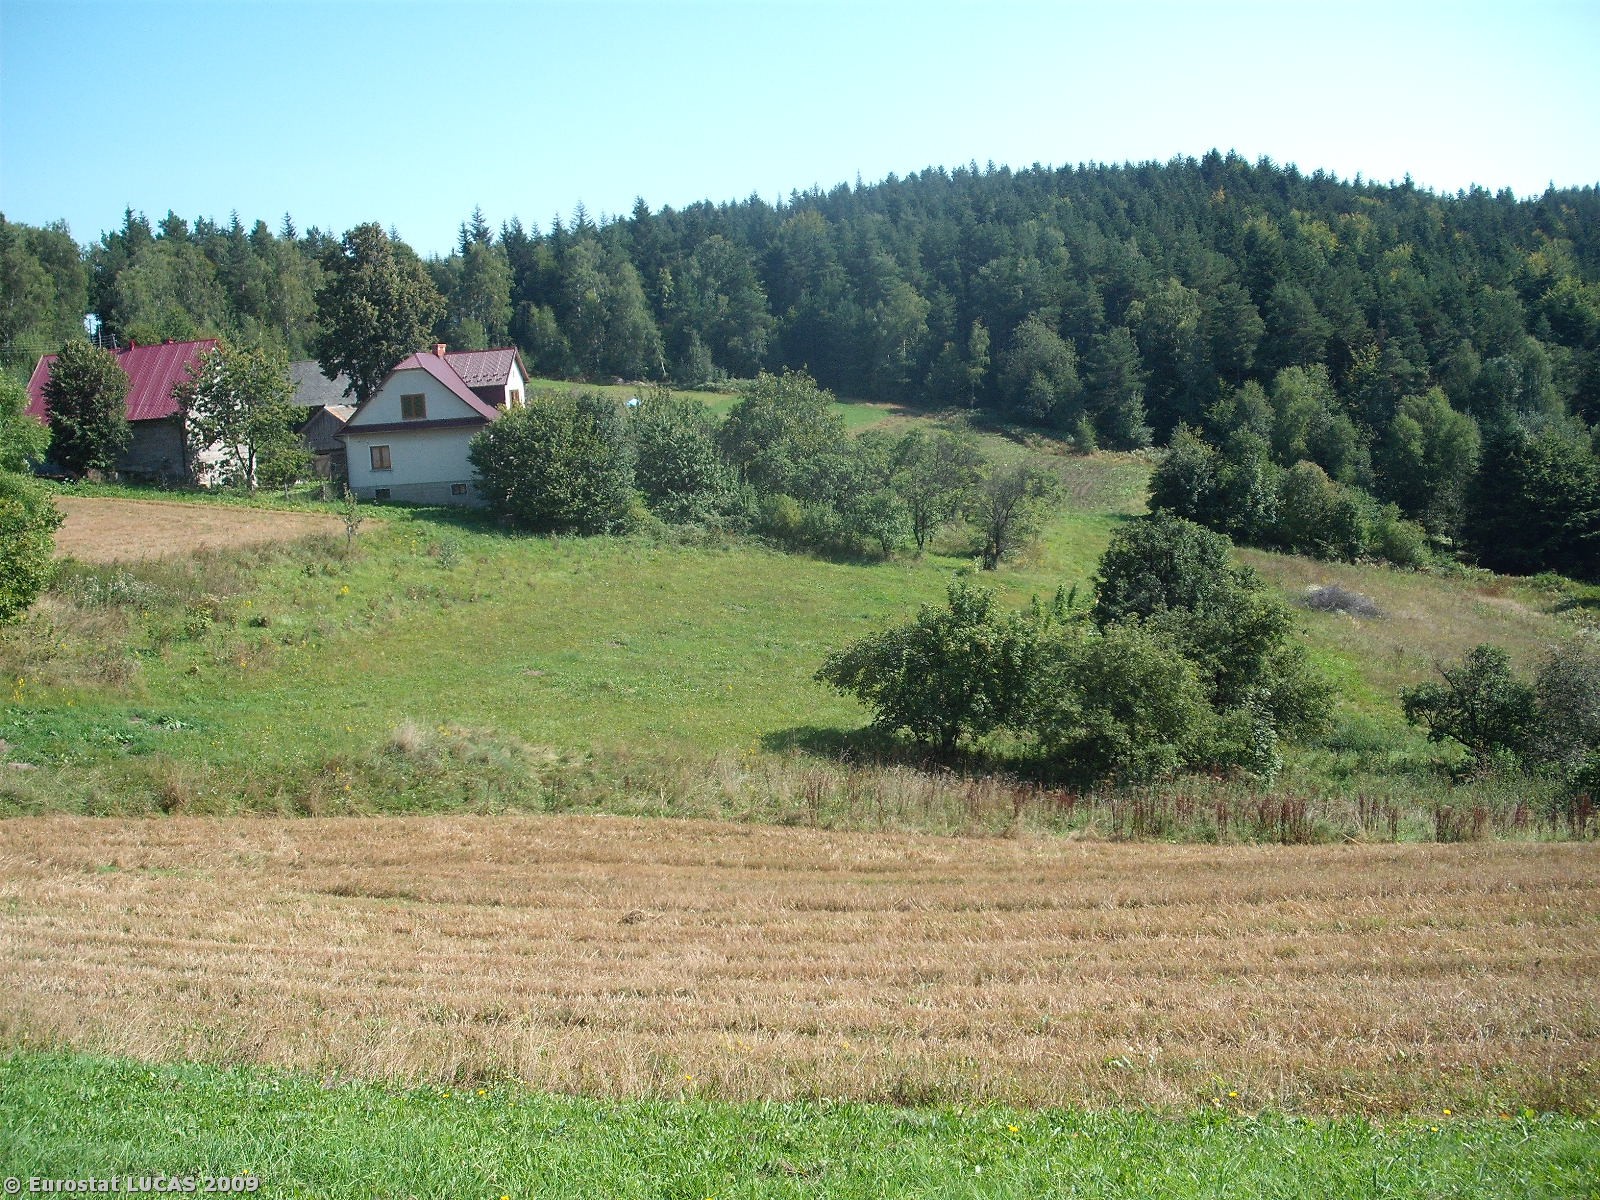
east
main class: Grassland
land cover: Grassland without tree/shrub cover
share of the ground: > 75 %
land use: Agriculture (excluding fallow land and kitchen gardens)
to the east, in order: Grassland without tree/shrub cover; Oats; Spontaneously vegetated surfaces; Shrubland with sparse tree cover; Spontaneously vegetated surfaces; Apple fruit; Potatoes; Common wheat; Spontaneously vegetated surfaces; Tracks; Mixed woodland
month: September
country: PL
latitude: 49.7102
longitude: 20.5635
